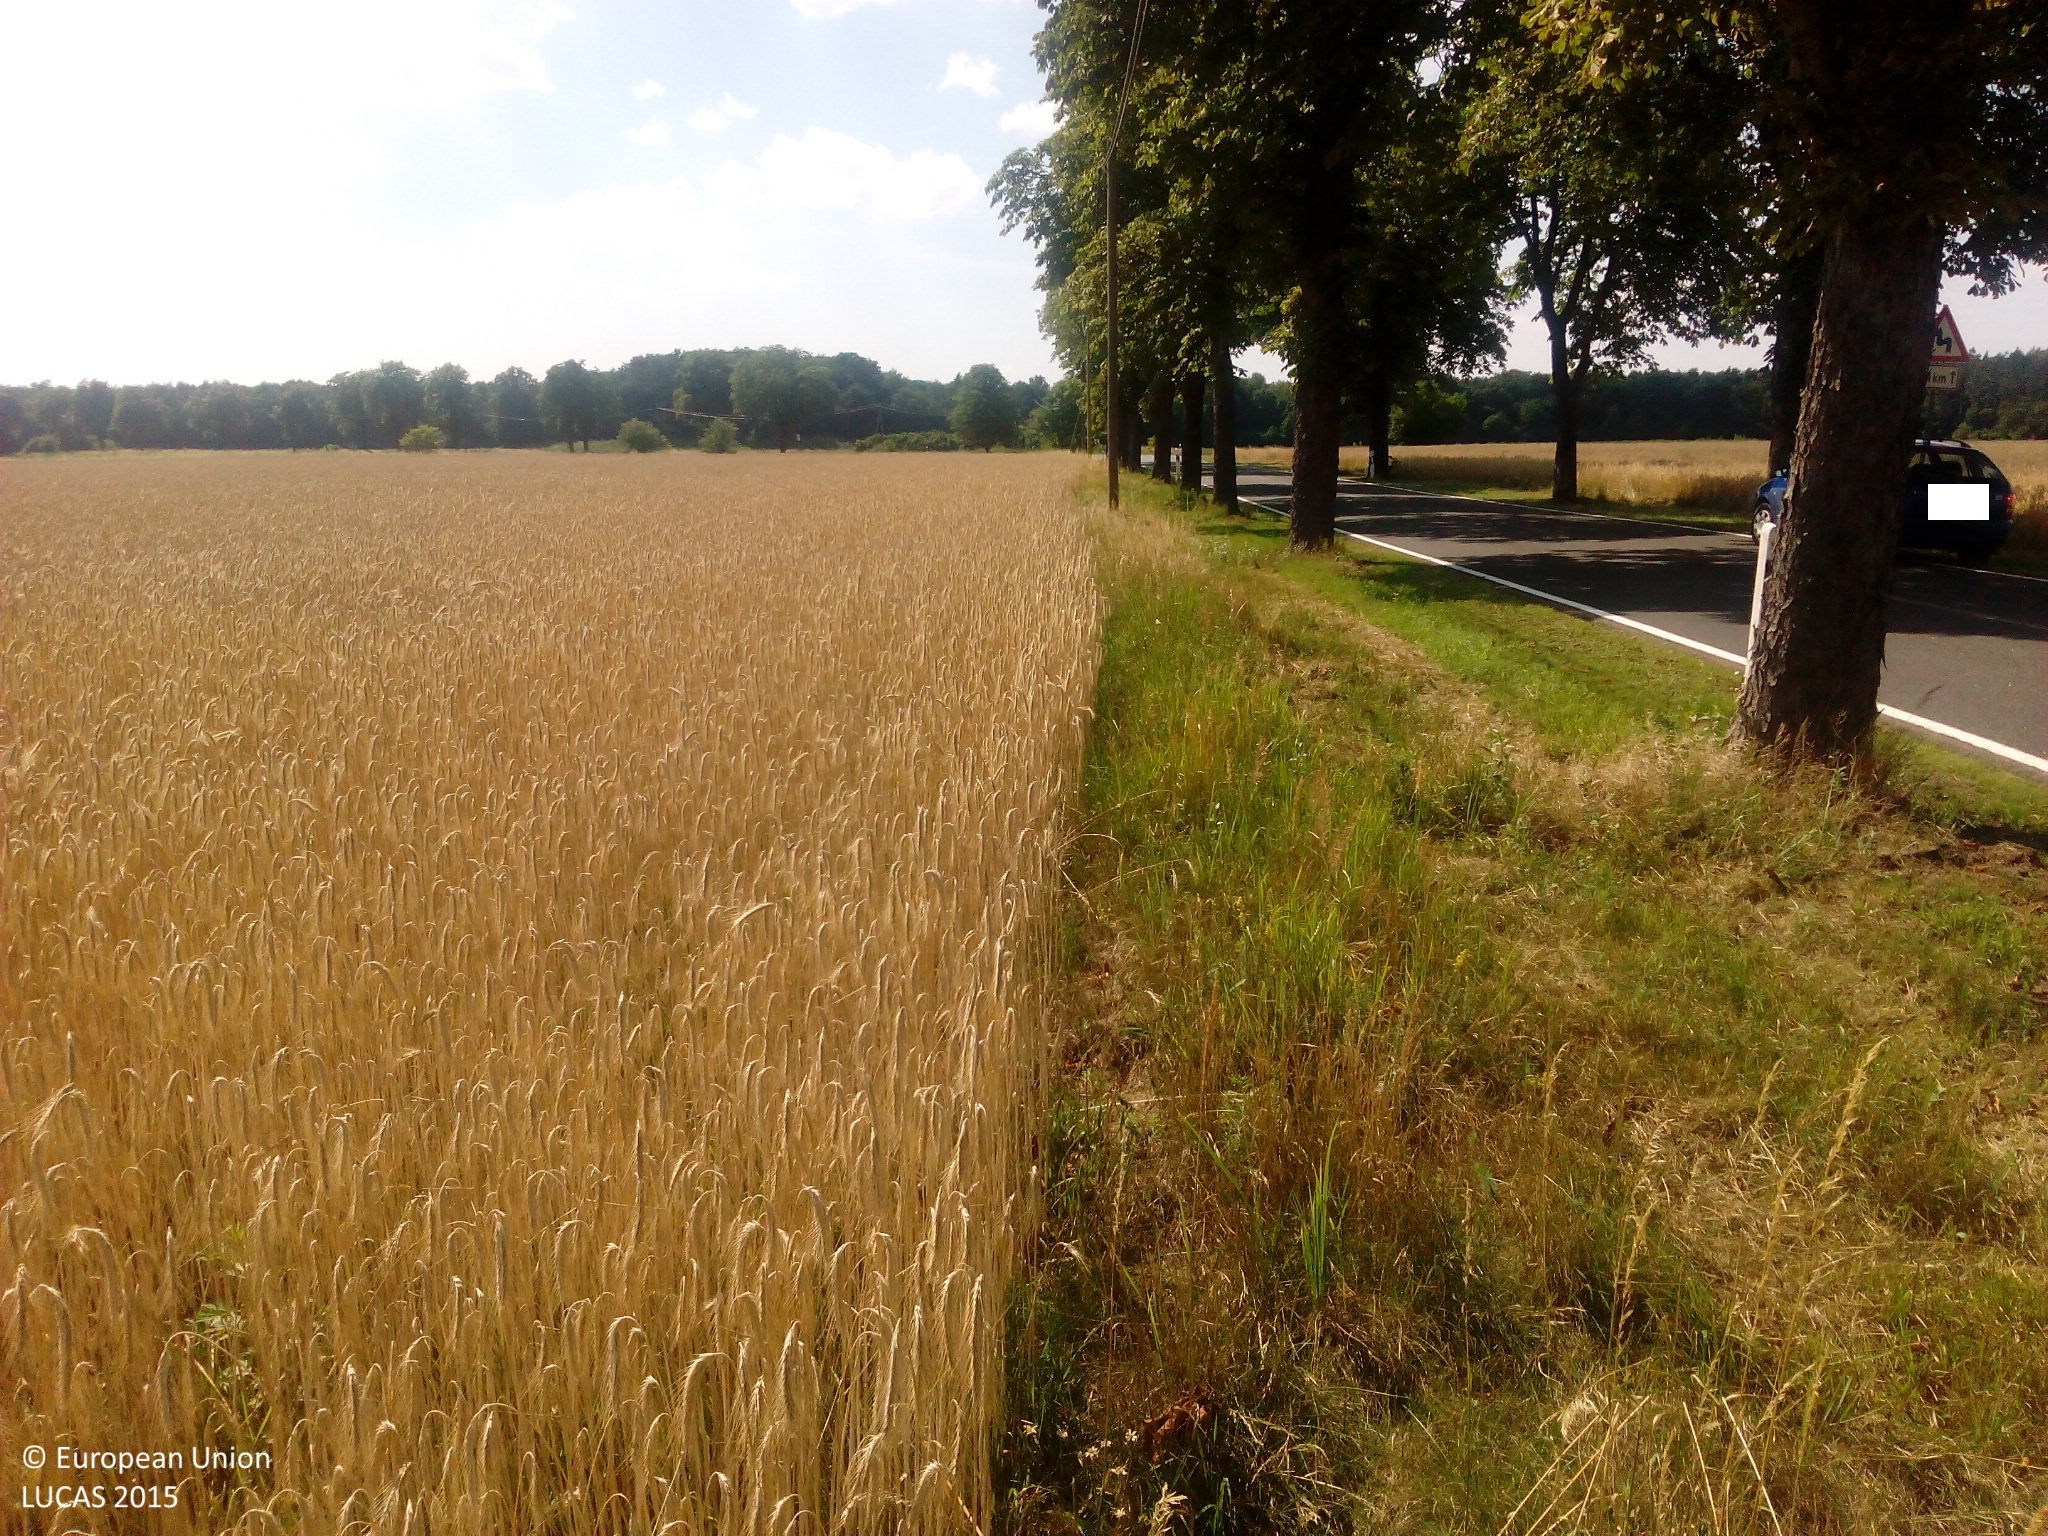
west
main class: Cropland
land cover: Rye
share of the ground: > 75 %
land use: Agriculture (excluding fallow land and kitchen gardens)
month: July
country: DE
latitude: 51.9234
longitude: 12.3117
